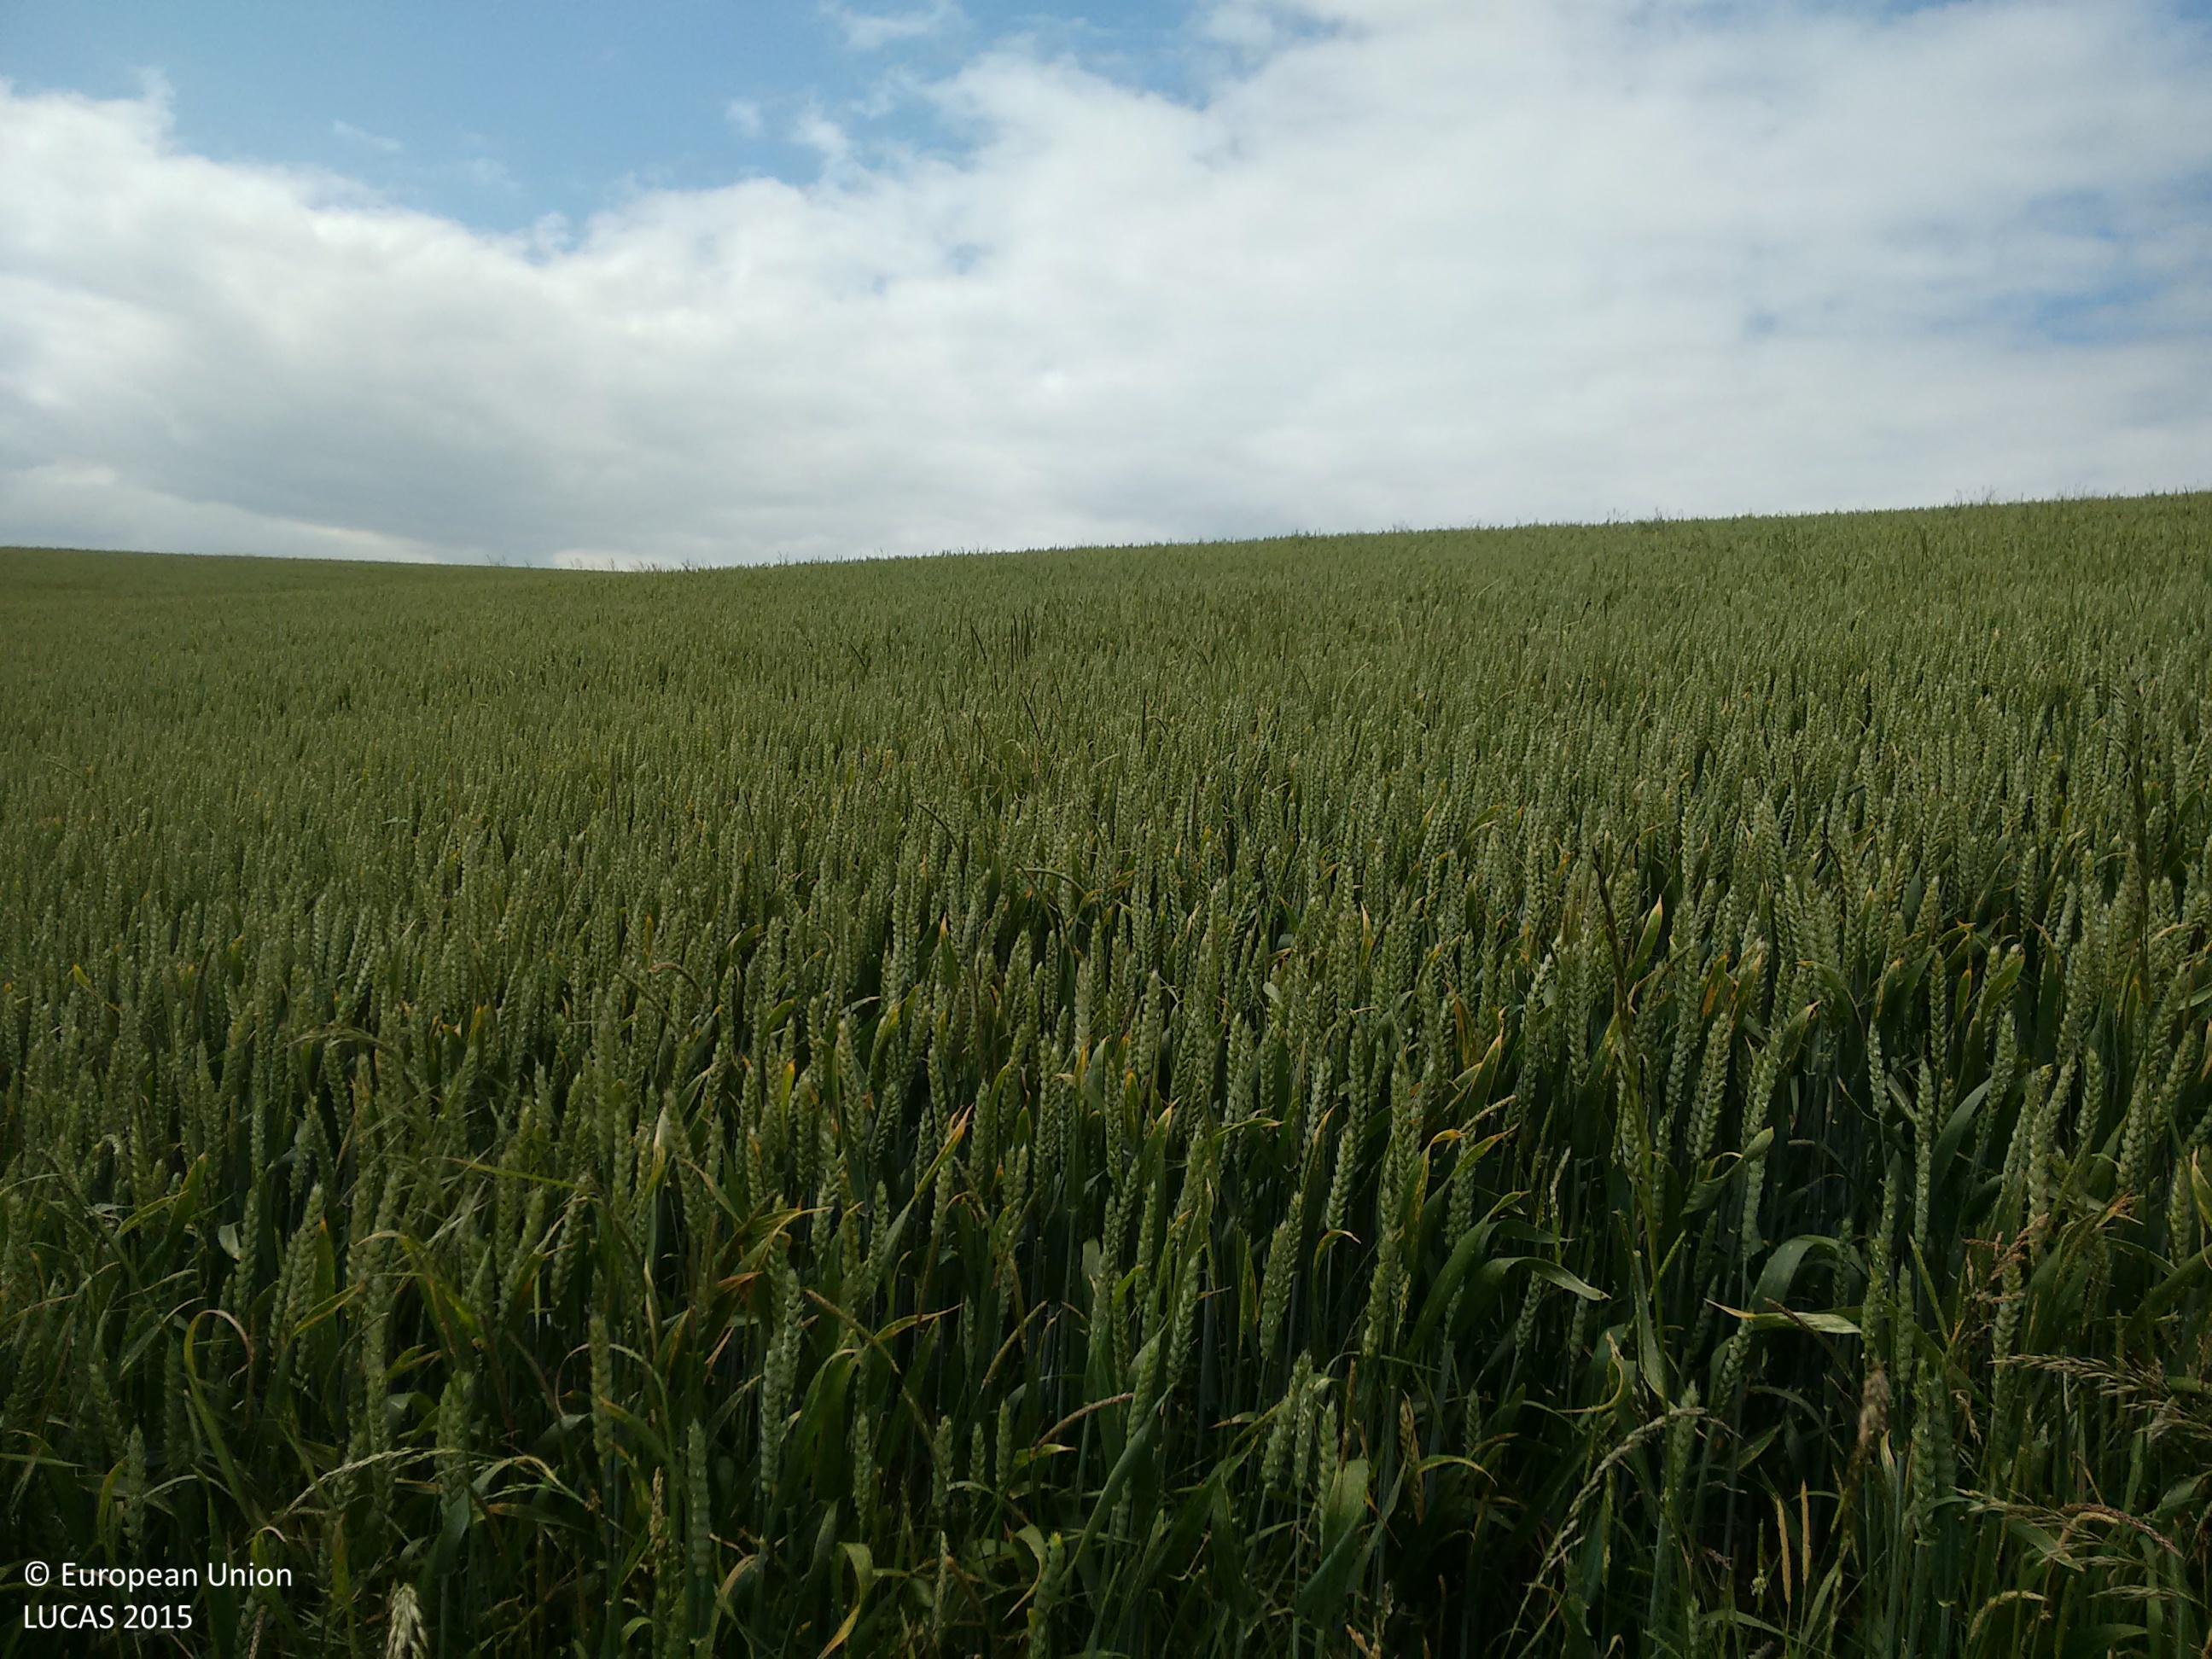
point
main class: Cropland
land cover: Common wheat
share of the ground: > 75 %
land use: Agriculture (excluding fallow land and kitchen gardens)
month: June
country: GB
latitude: 50.8933
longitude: -0.1138
